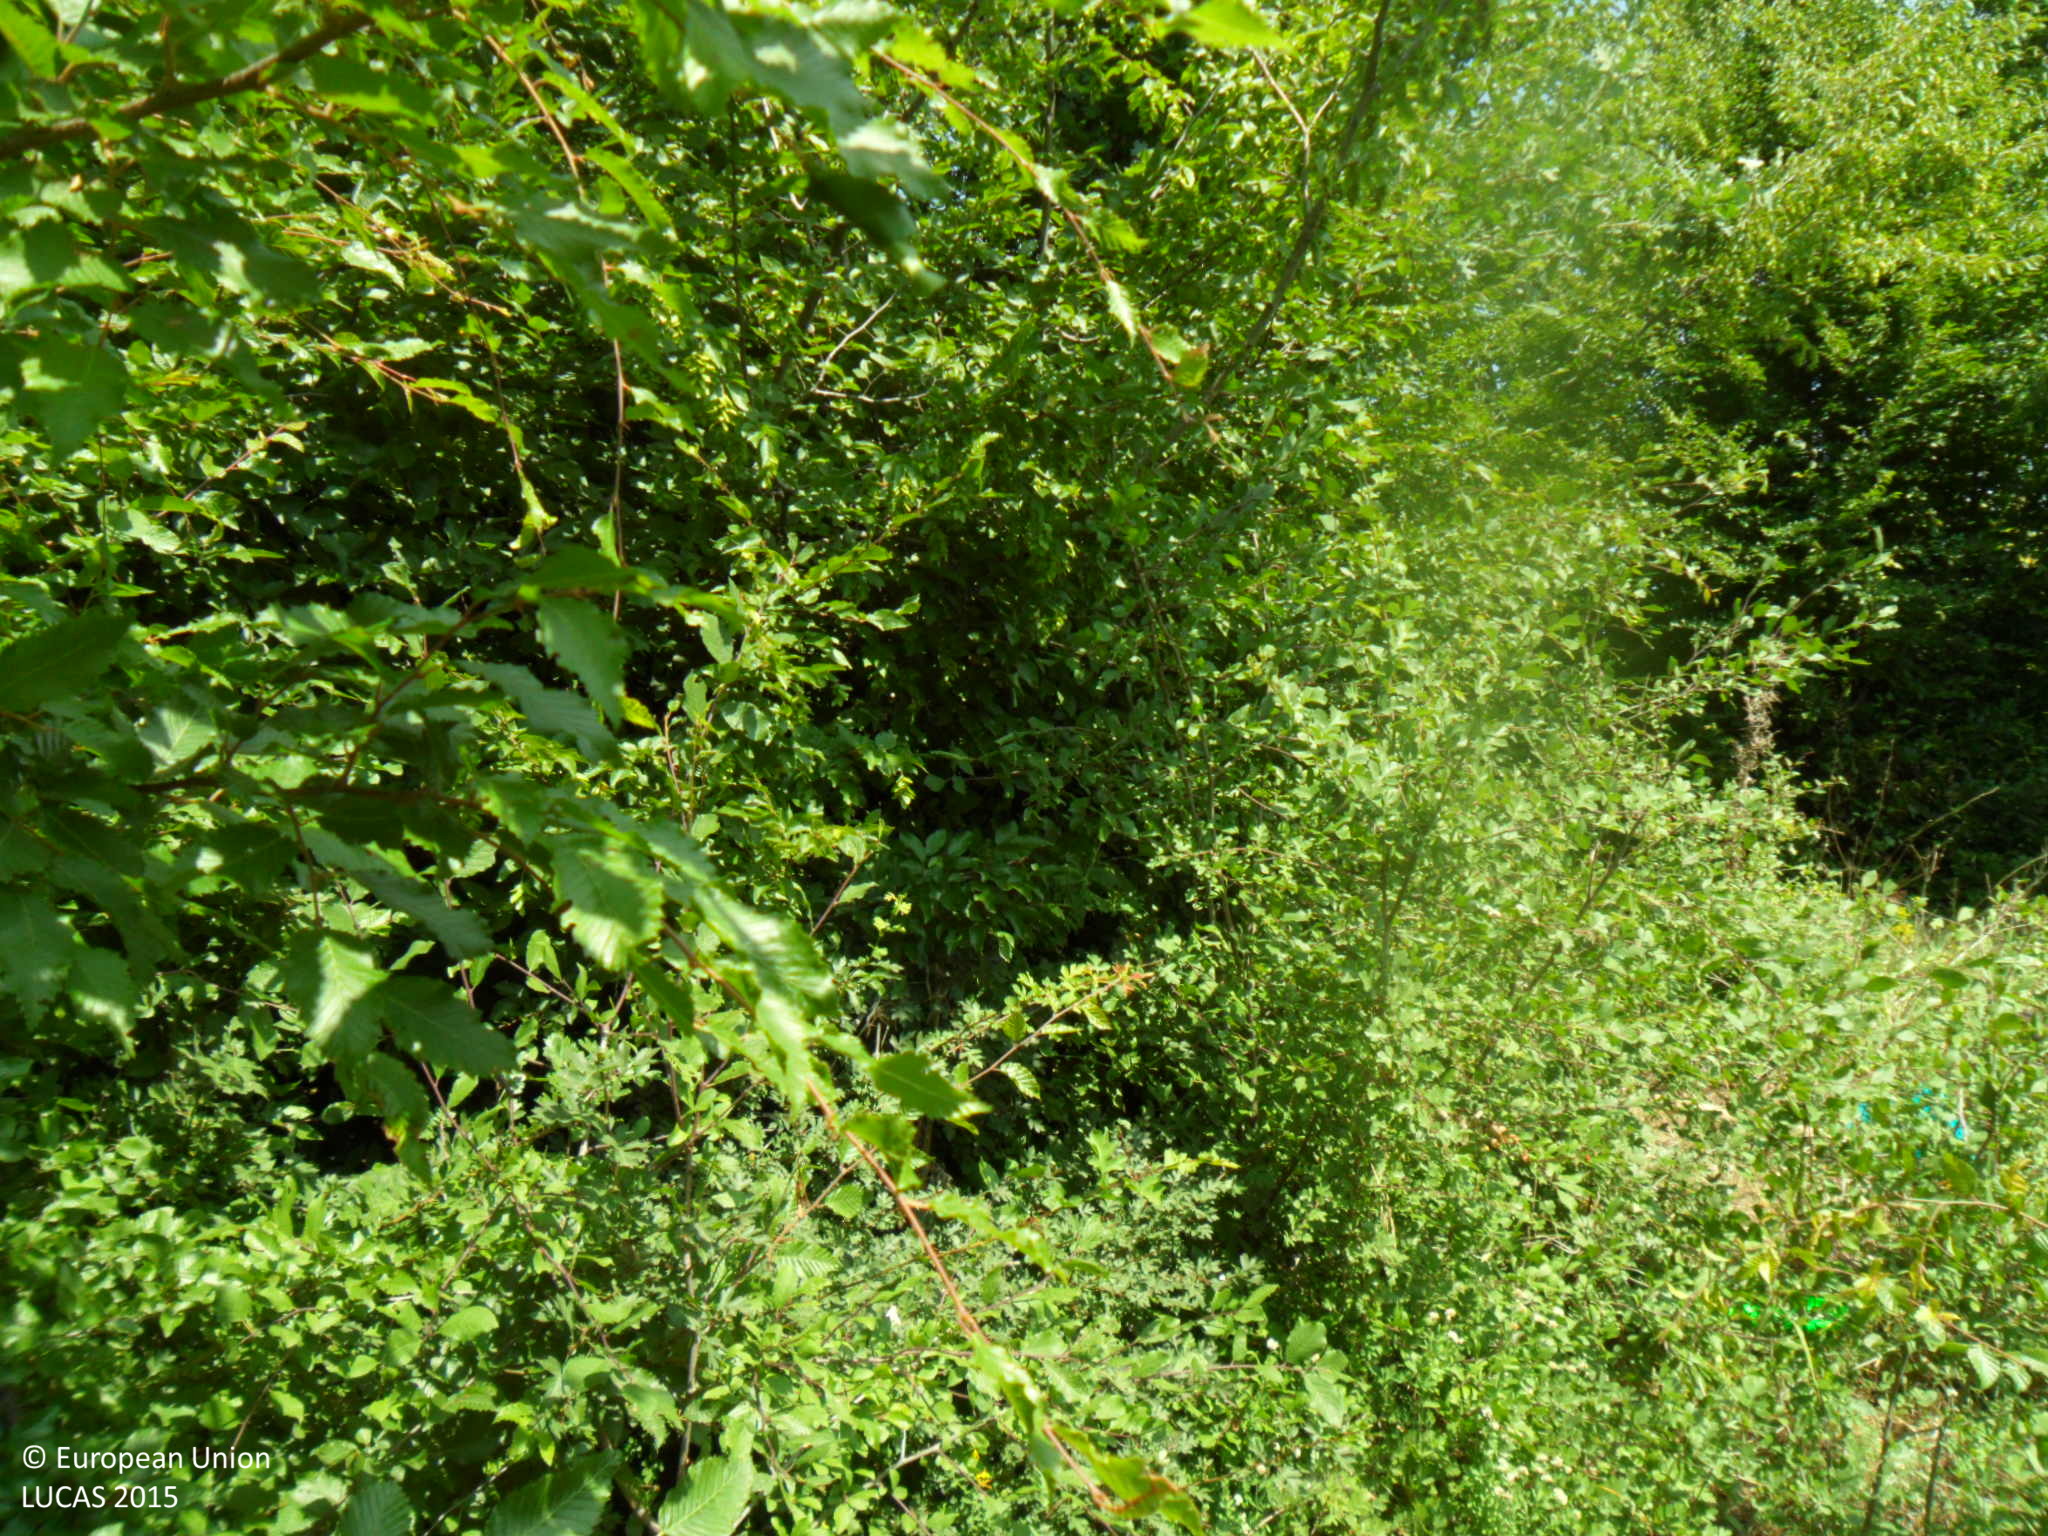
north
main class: Woodland
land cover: Broadleaved woodland
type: mesophytic deciduous forest
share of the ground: > 75 %
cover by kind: broadleaved forest trees 95 %, shrubs 5 %
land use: Forestry
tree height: > 5 m
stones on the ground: 10 - 25 %
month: June
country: BG
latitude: 43.4408
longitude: 27.0575
